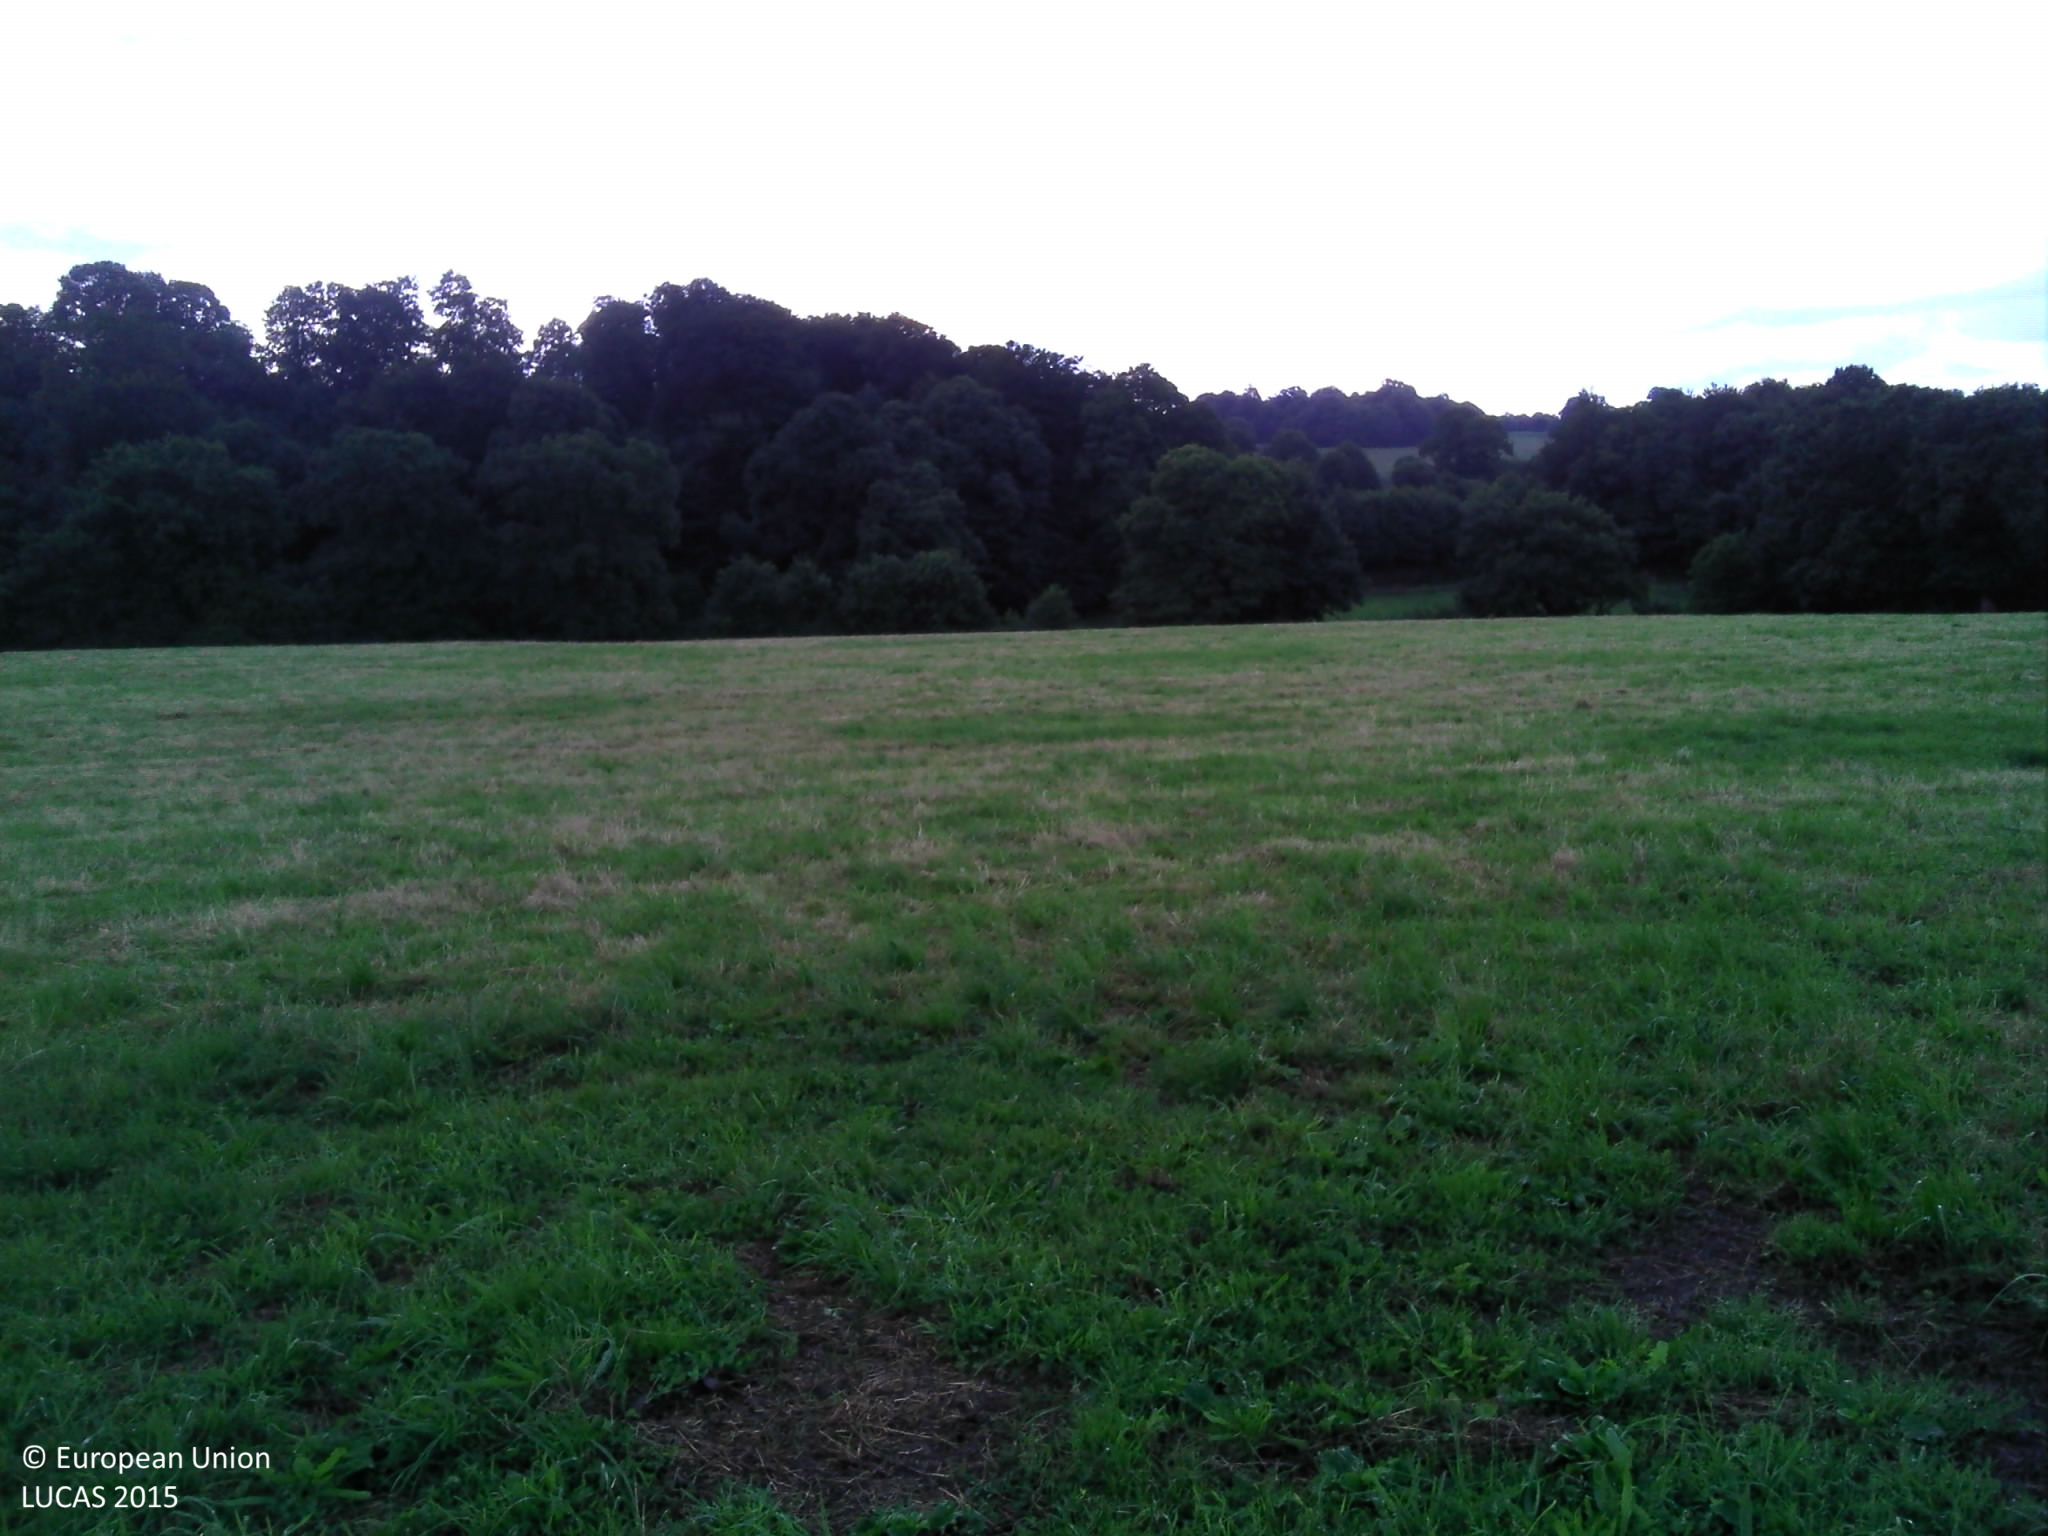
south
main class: Grassland
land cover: Grassland without tree/shrub cover
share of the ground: > 75 %
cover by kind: herbaceous plants 100 %
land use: Agriculture (excluding fallow land and kitchen gardens)
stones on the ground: < 10 %
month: July
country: FR
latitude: 48.7371
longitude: -1.2348
